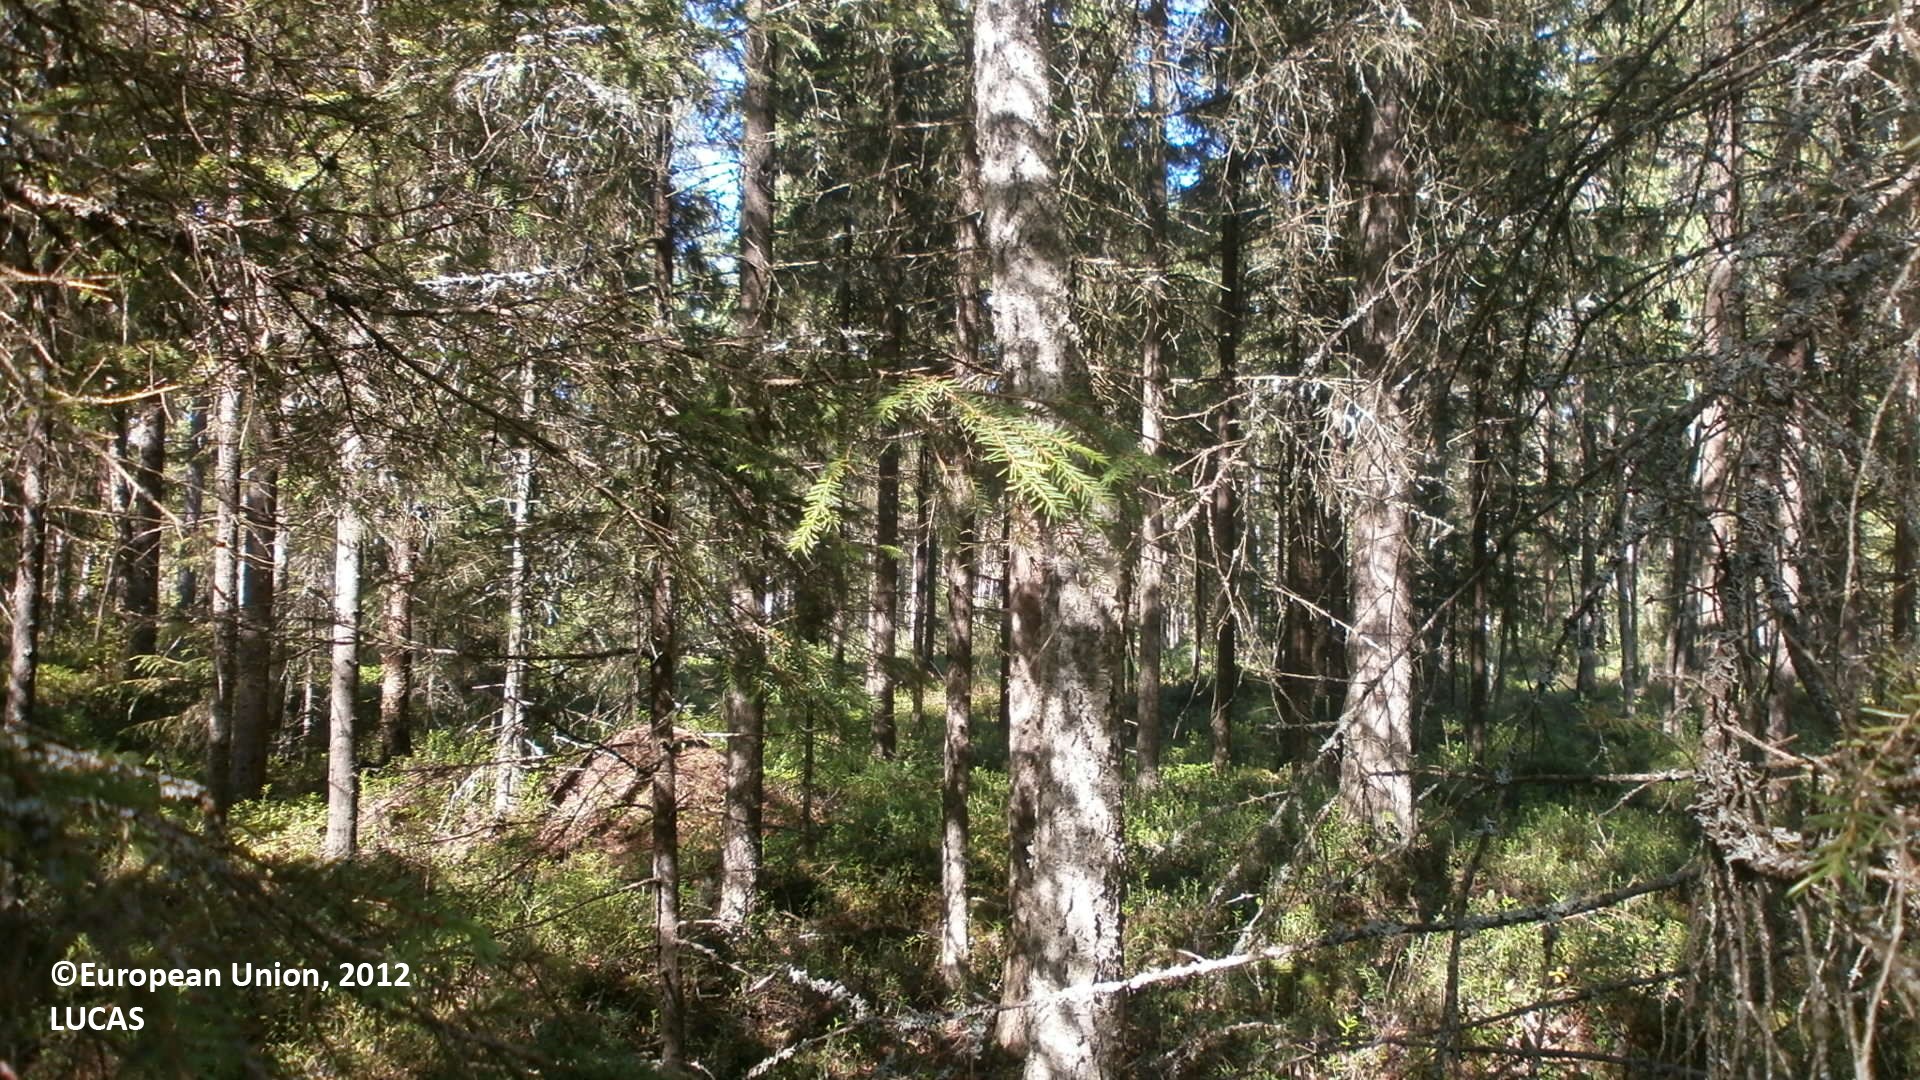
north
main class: Woodland
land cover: Spruce dominated coniferous woodland
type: boreal forest
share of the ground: > 75 %
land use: Forestry
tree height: > 5 m
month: July
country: FI
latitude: 64.3307
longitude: 23.9443
